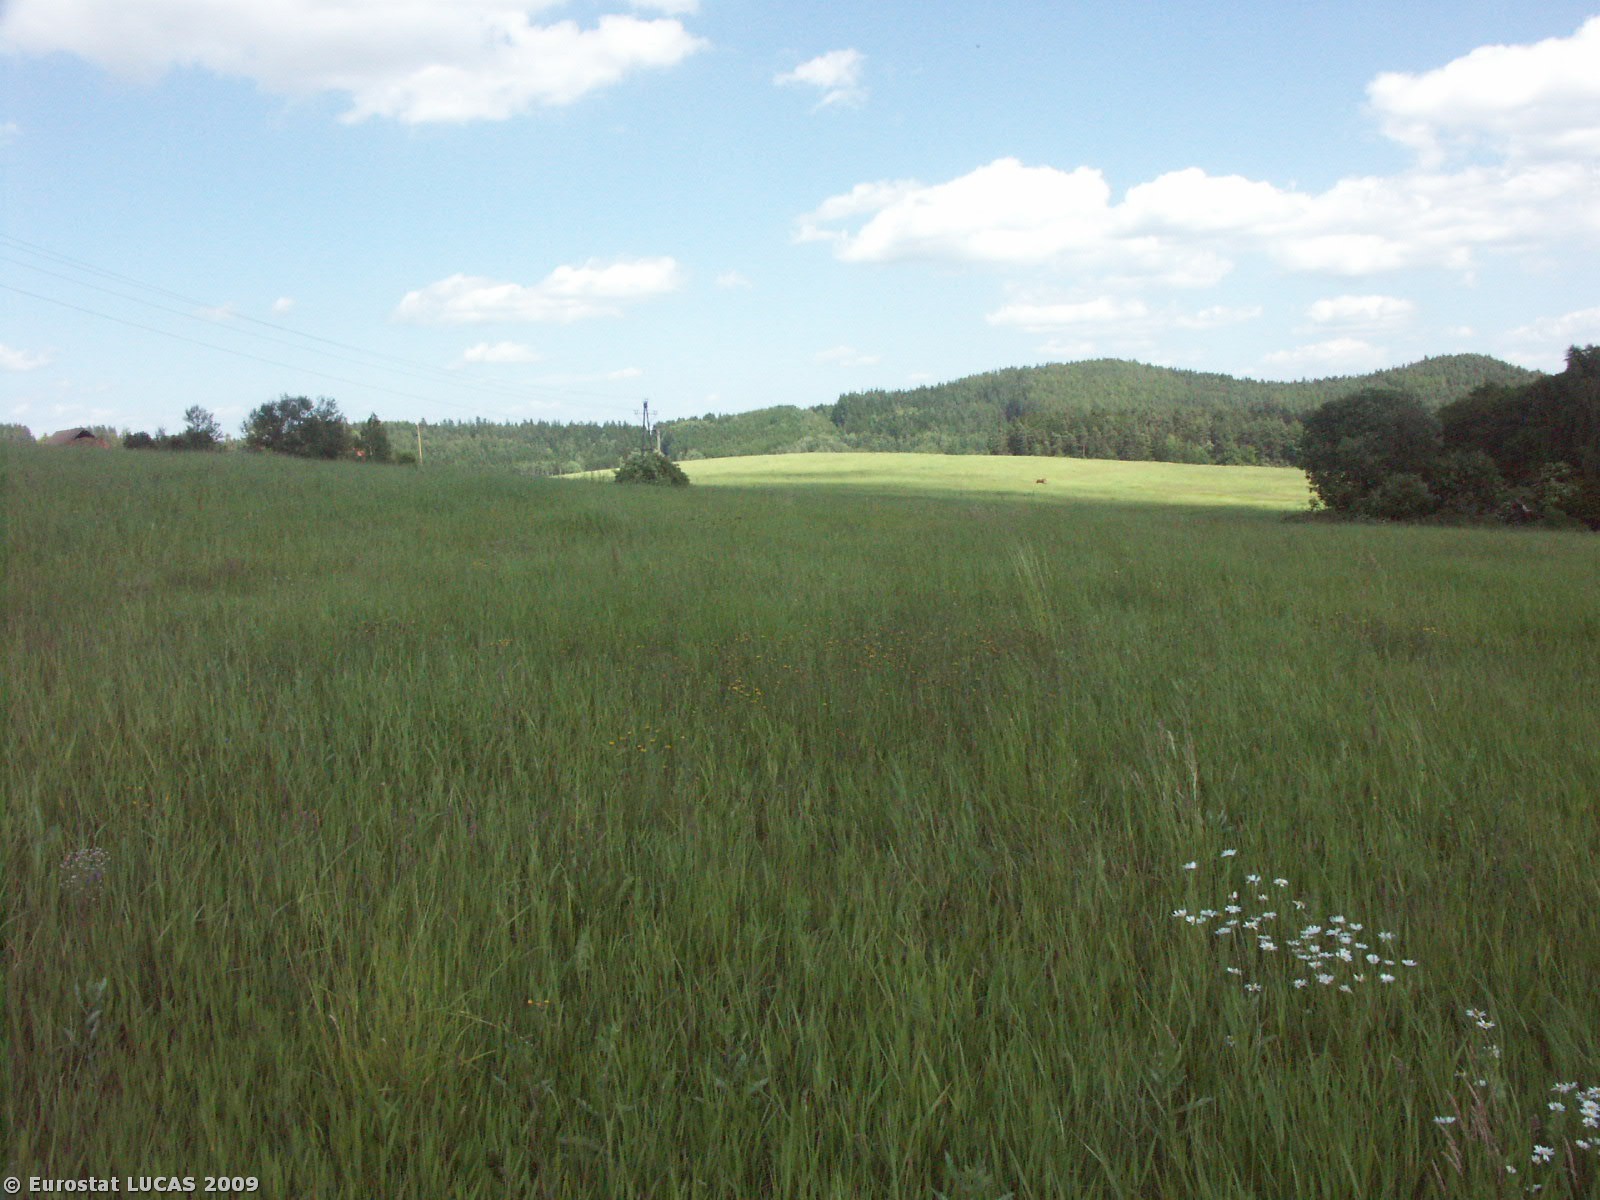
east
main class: Grassland
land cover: Grassland without tree/shrub cover
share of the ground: > 75 %
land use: Agriculture (excluding fallow land and kitchen gardens)
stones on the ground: < 10 %
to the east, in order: Grassland without tree/shrub cover
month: June
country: CZ
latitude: 48.7296
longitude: 14.4192
